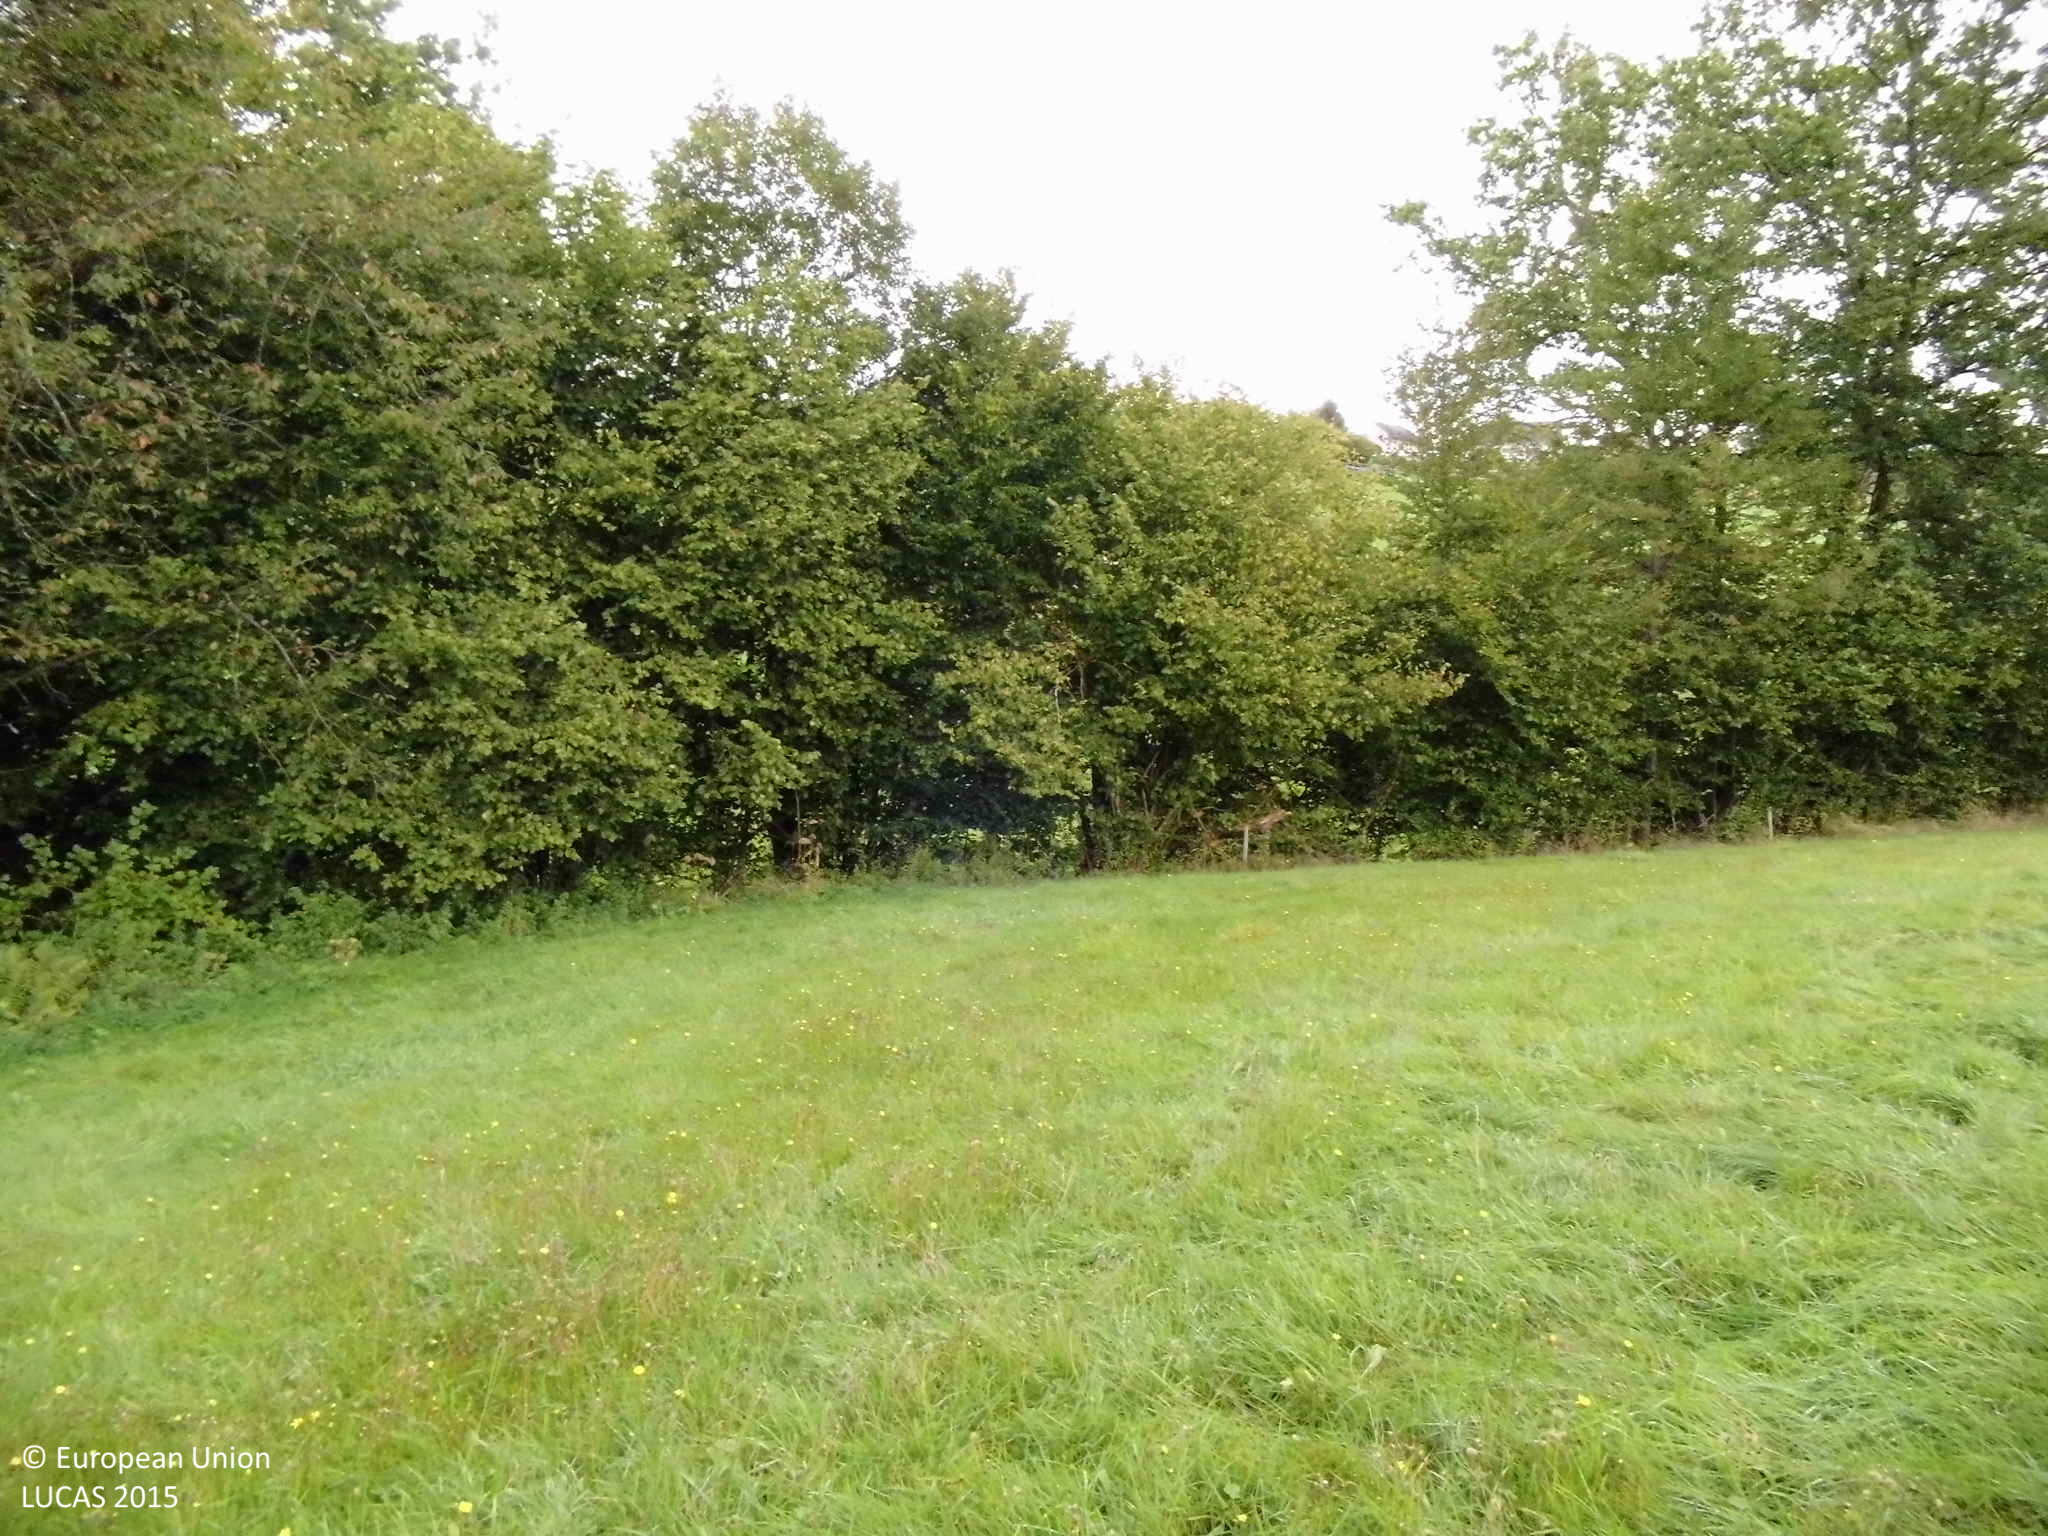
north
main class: Grassland
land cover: Grassland without tree/shrub cover
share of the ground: > 75 %
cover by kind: herbaceous plants 100 %
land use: Agriculture (excluding fallow land and kitchen gardens)
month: September
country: DE
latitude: 50.6592
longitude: 7.4398
